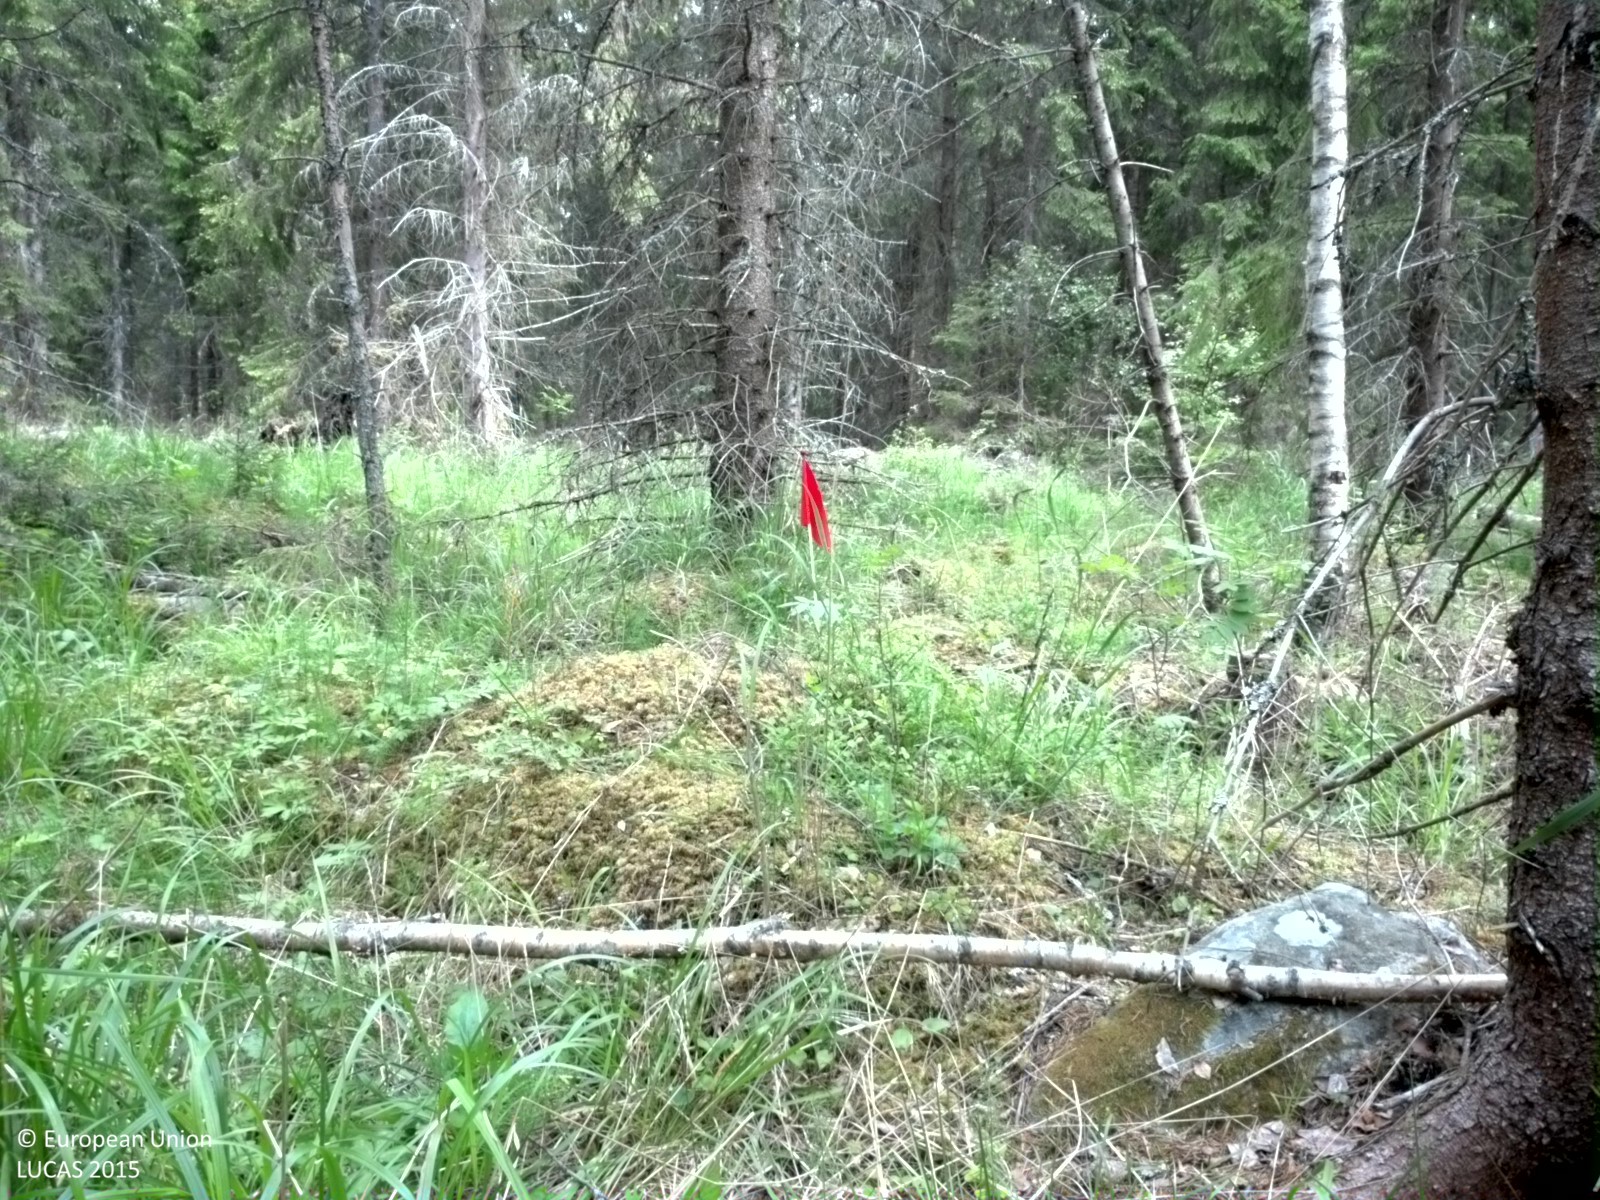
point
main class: Woodland
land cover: Spruce dominated coniferous woodland
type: boreal forest
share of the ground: 50 - 75 %
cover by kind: coniferous forest trees 60 %, herbaceous plants 25 %, broadleaved forest trees 5 %, lichens and mosses 5 %
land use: Forestry
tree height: > 5 m
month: June
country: SE
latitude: 60.2769
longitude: 17.0242
